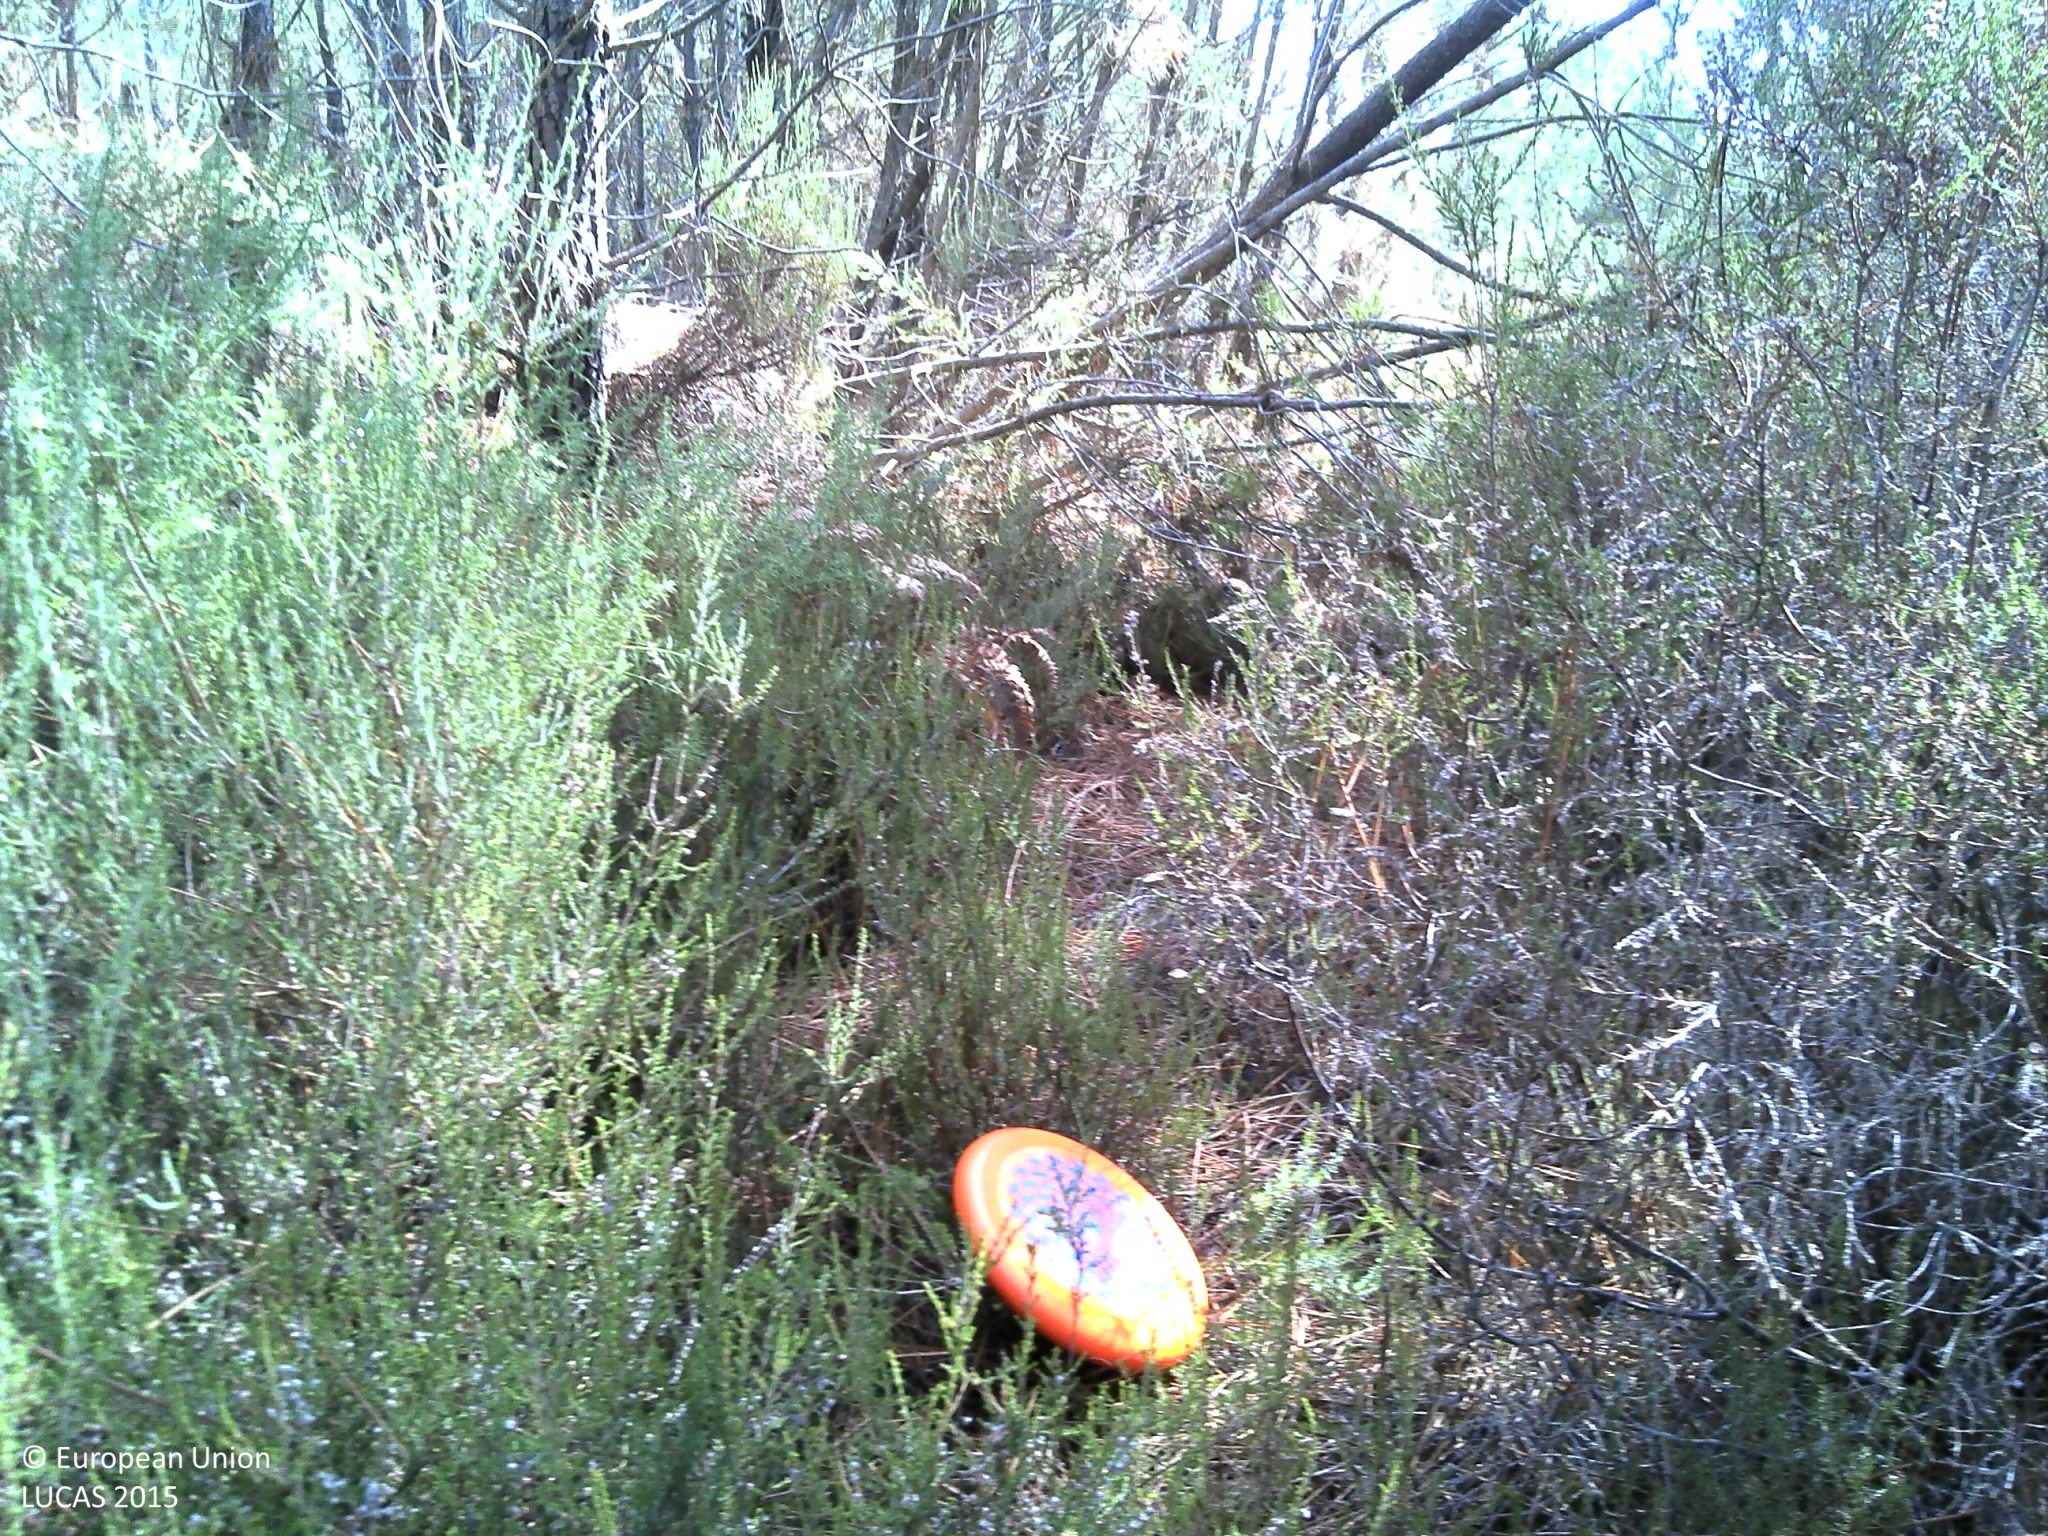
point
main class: Woodland
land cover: Pine dominated coniferous woodland
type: coniferous forest of the mediterranean region
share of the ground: > 75 %
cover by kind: coniferous forest trees 60 %, shrubs 30 %, herbaceous plants 5 %, lichens and mosses 5 %
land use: Forestry
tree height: > 5 m
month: July
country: FR
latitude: 44.4134
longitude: -0.5269
